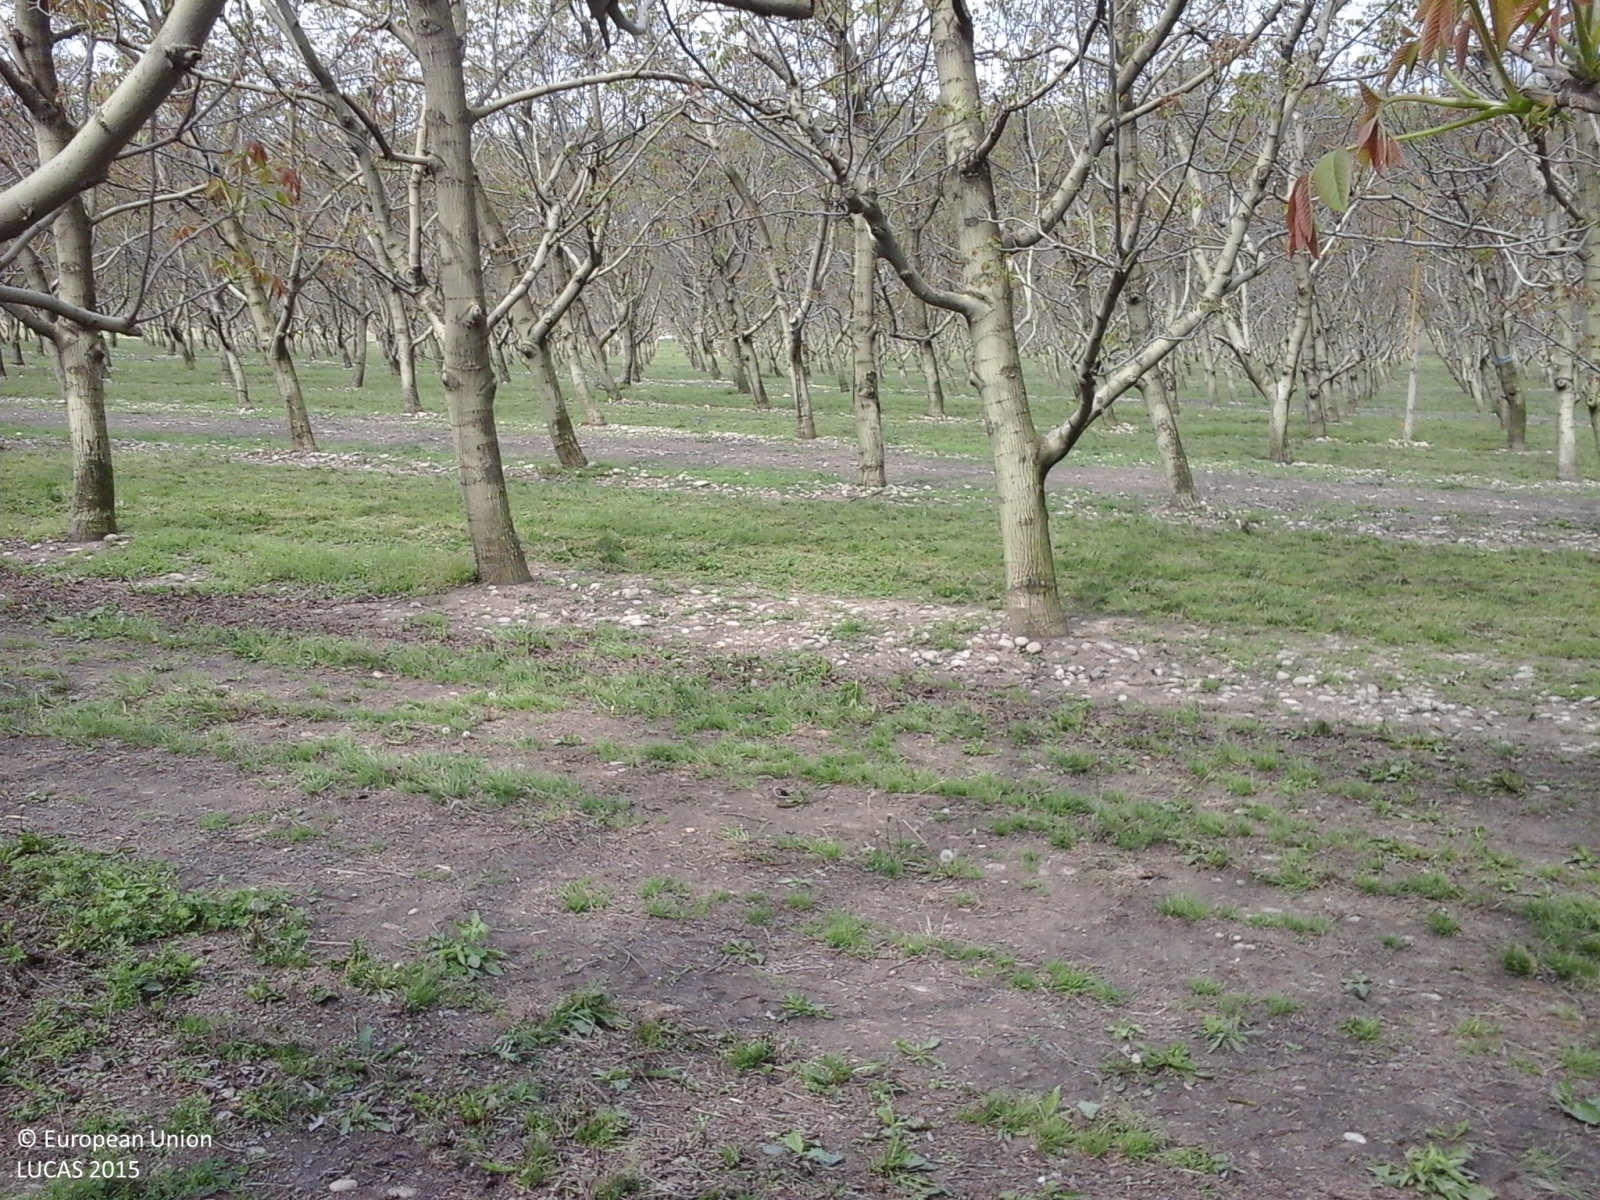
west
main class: Cropland
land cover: Nuts trees
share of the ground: 50 - 75 %
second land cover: Grassland without tree/shrub cover
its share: 50 - 75 %
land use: Agriculture (excluding fallow land and kitchen gardens)
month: May
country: IT
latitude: 44.5973
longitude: 7.7747
